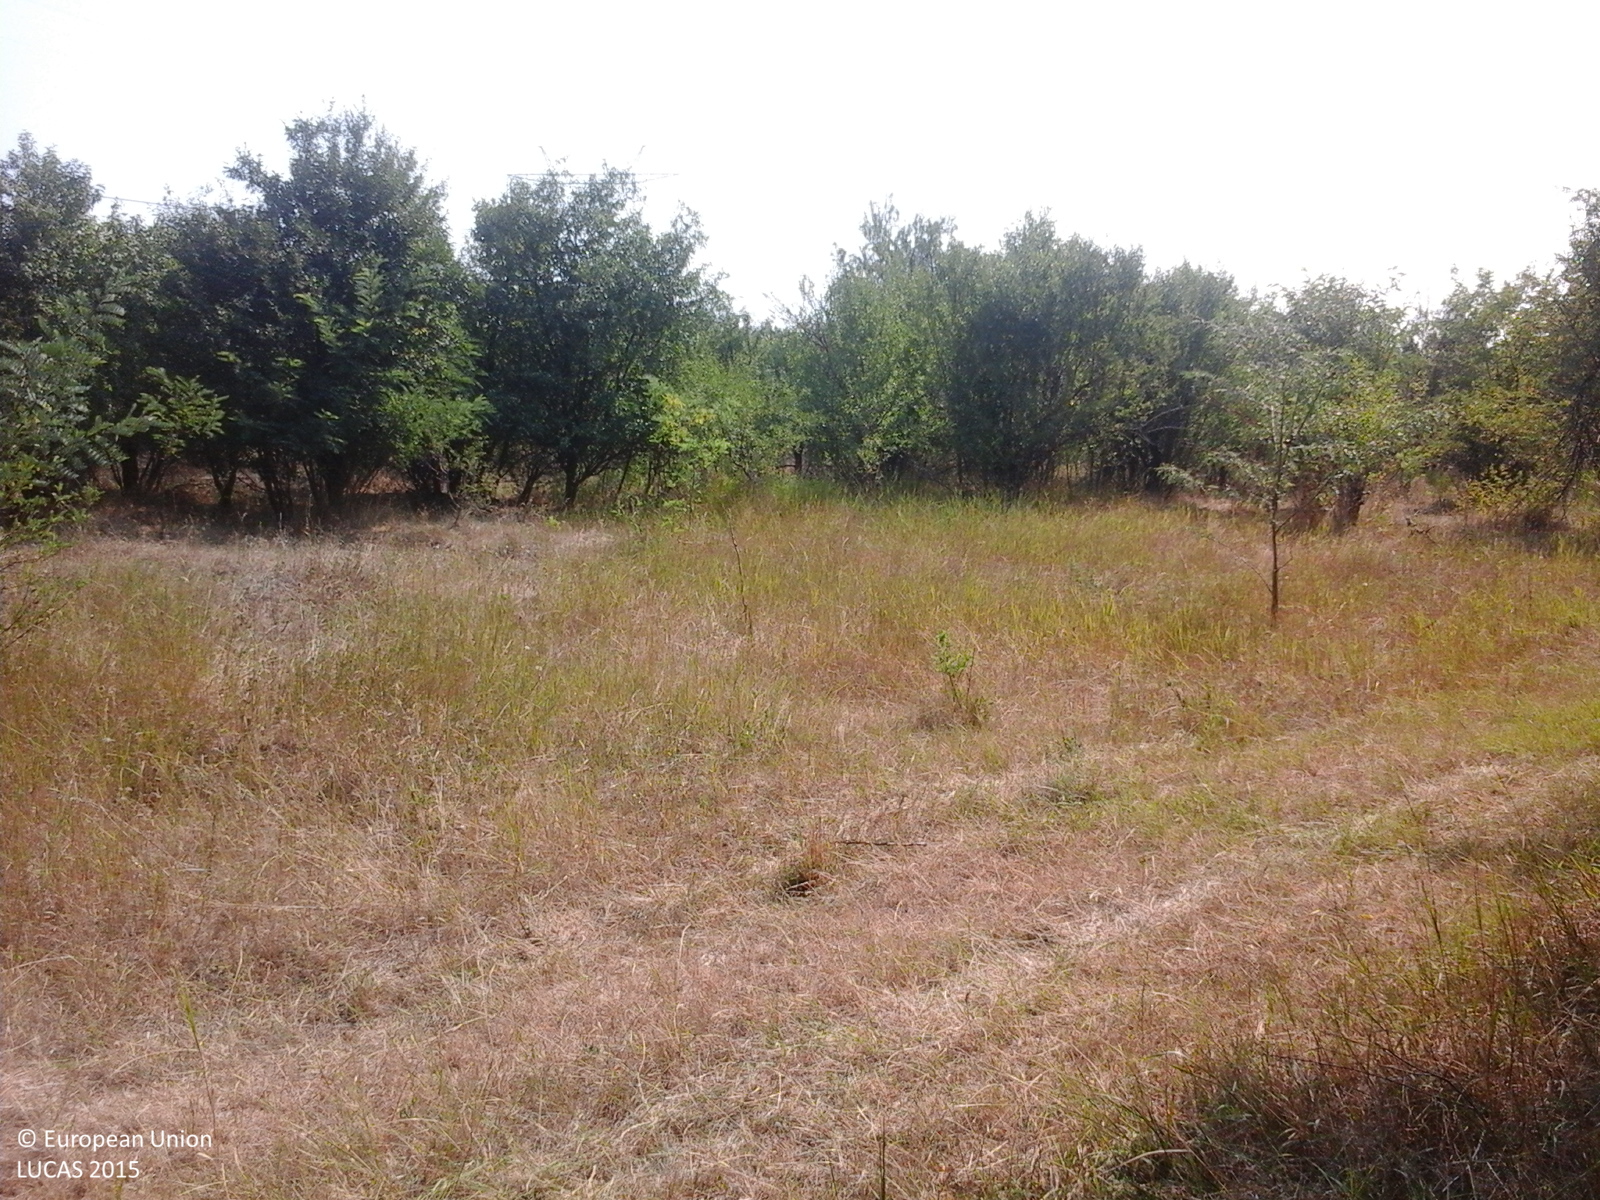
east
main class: Woodland
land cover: Broadleaved woodland
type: exotic forest
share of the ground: > 75 %
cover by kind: broadleaved forest trees 100 %
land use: Forestry
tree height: > 5 m
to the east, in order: Broadleaved woodland; Fences; Grass margins; Tracks; Grass margins; Other fruit trees and berries; Grass margins; Tracks; Grass margins; Fences; Broadleaved woodland; Fences; Grass margins; Tracks; Grass margins; Other fruit trees and berries
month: July
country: RO
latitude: 45.5987
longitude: 27.5794
